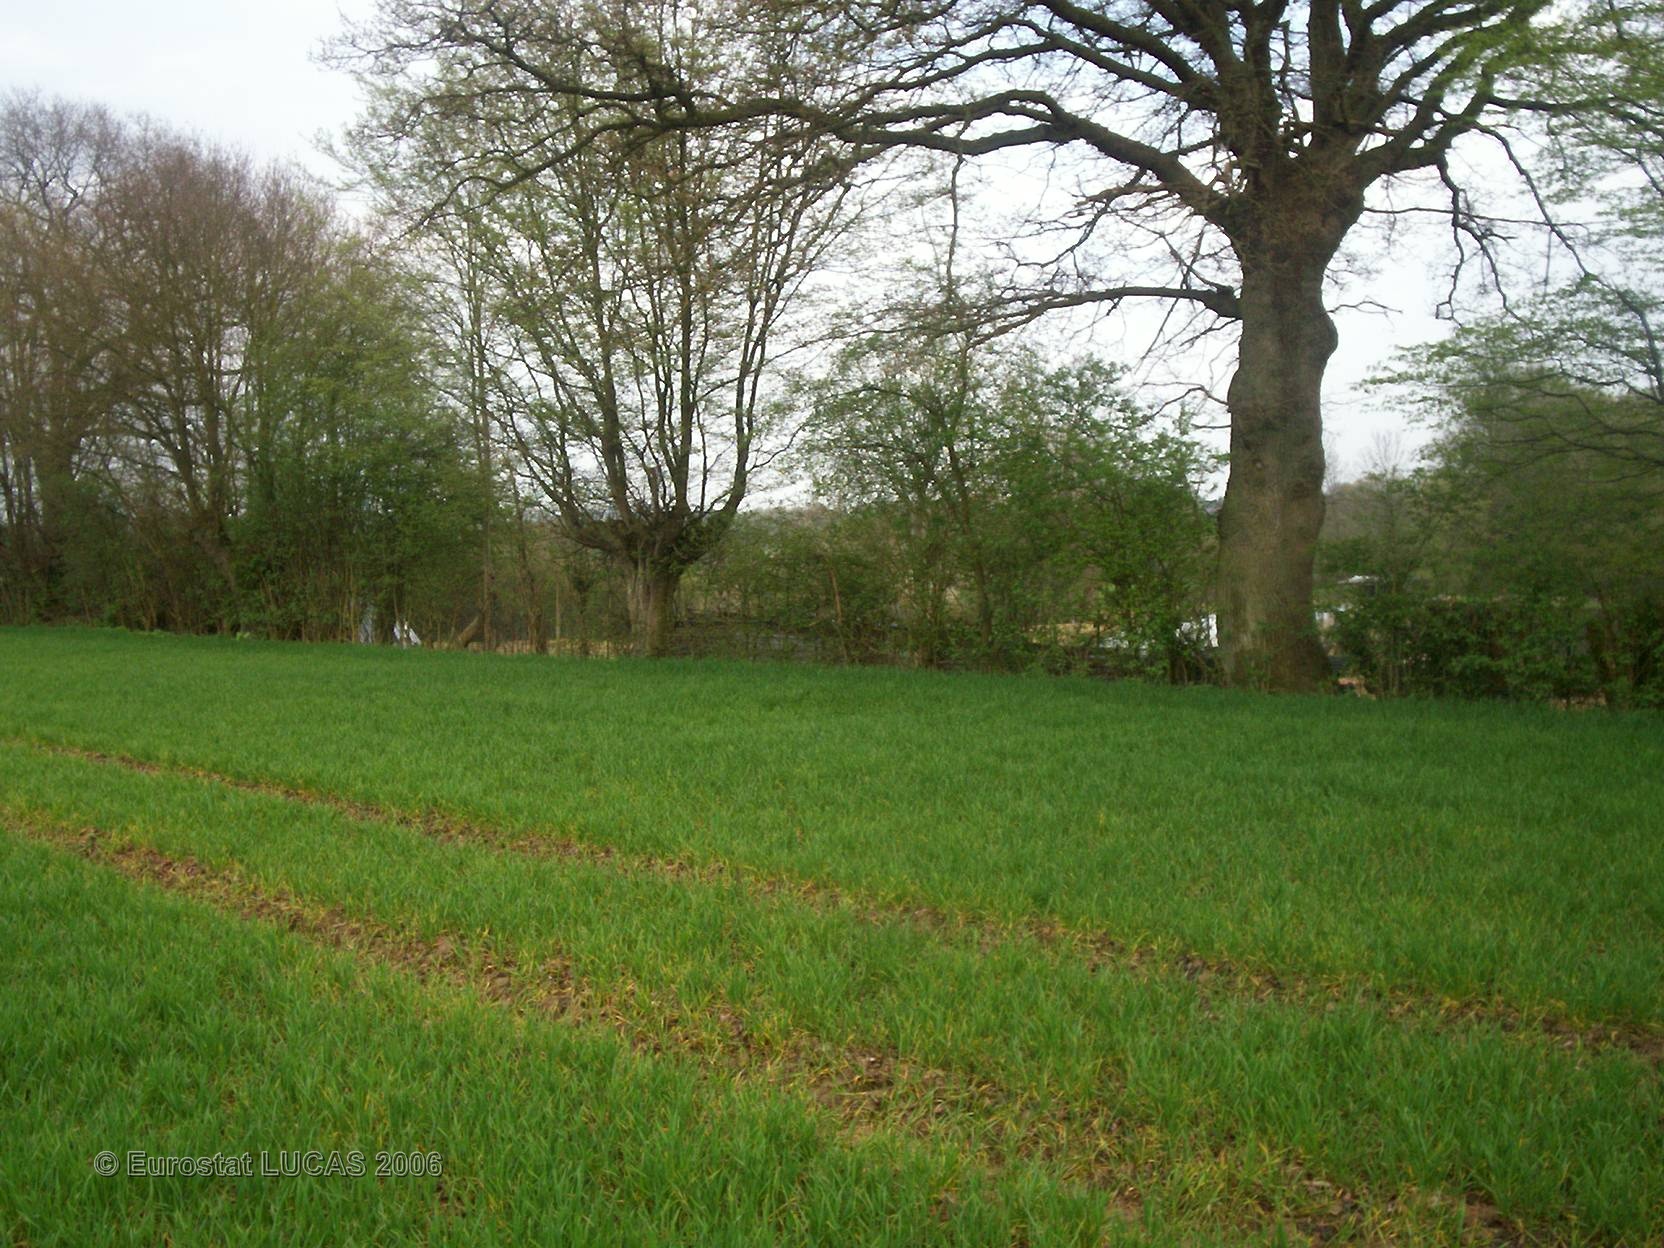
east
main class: Cropland
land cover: Common wheat
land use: Agriculture (excluding fallow land and kitchen gardens)
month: April
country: FR
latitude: 50.1952
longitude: 3.7880
